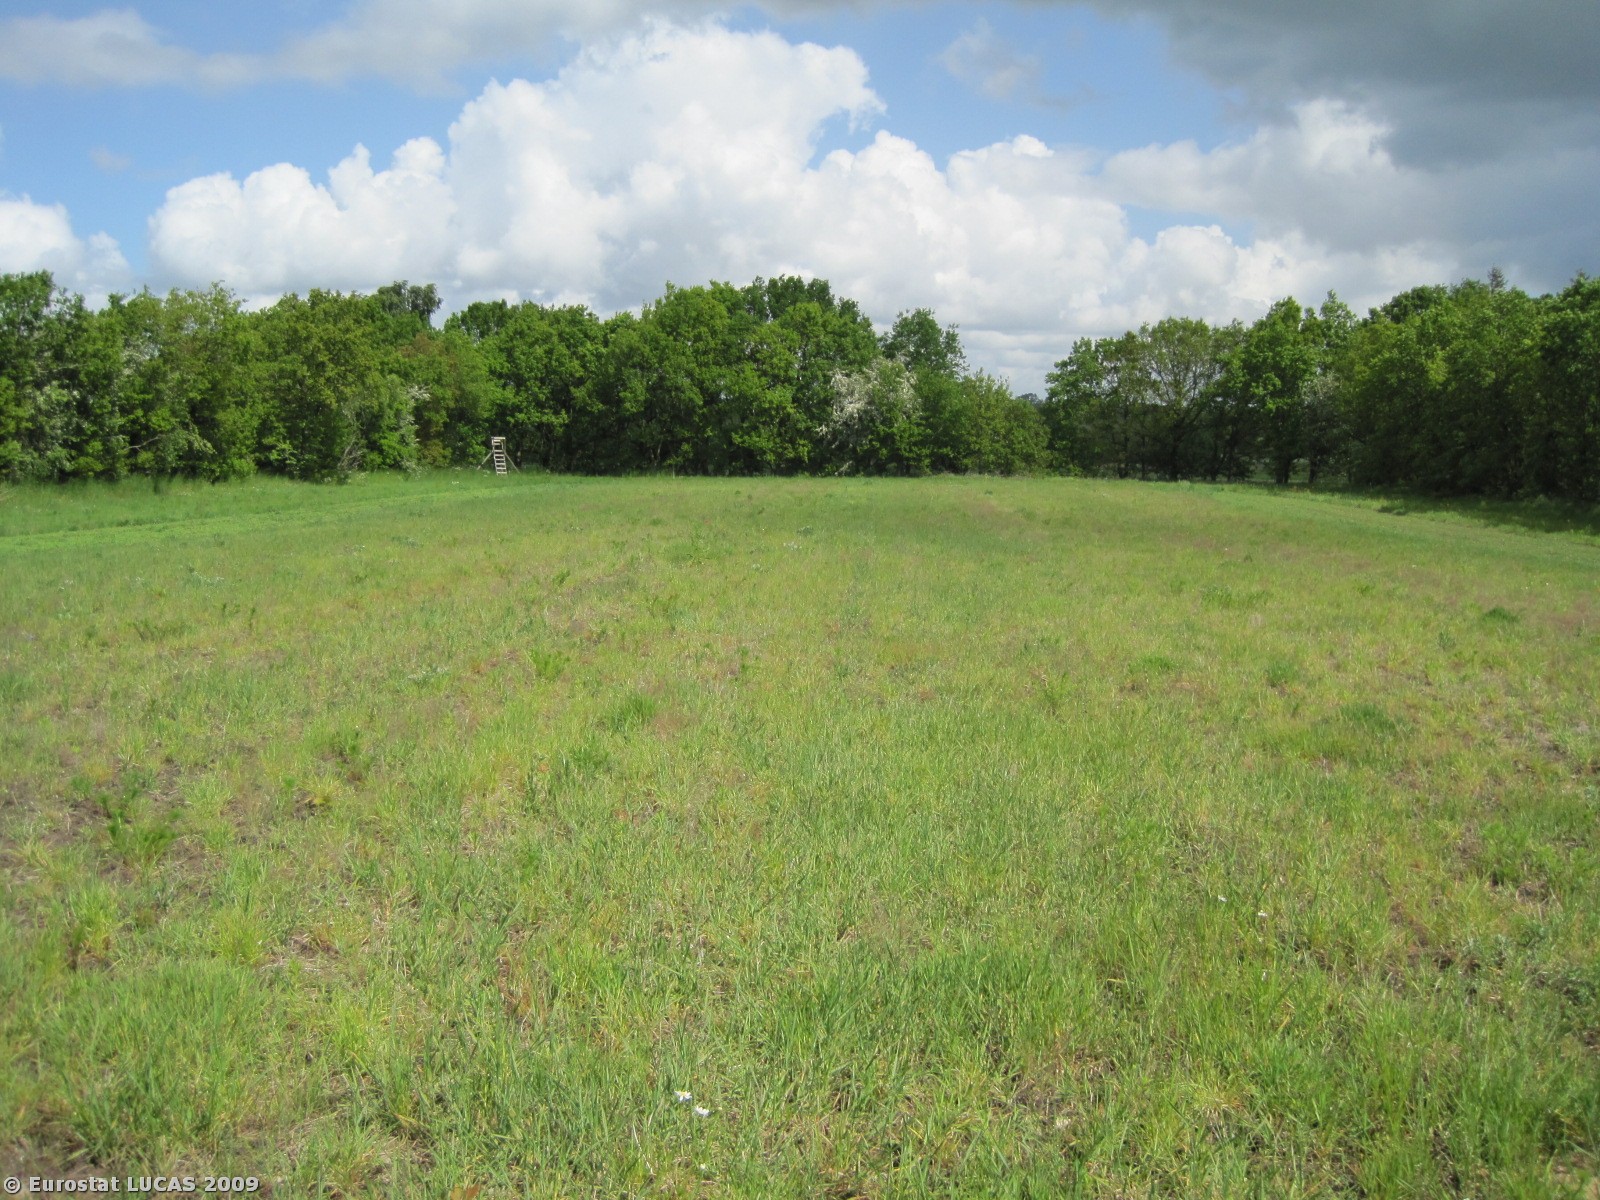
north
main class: Grassland
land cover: Grassland without tree/shrub cover
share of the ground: > 75 %
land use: Agriculture (excluding fallow land and kitchen gardens)
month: May
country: DK
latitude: 56.5471
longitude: 9.7888
